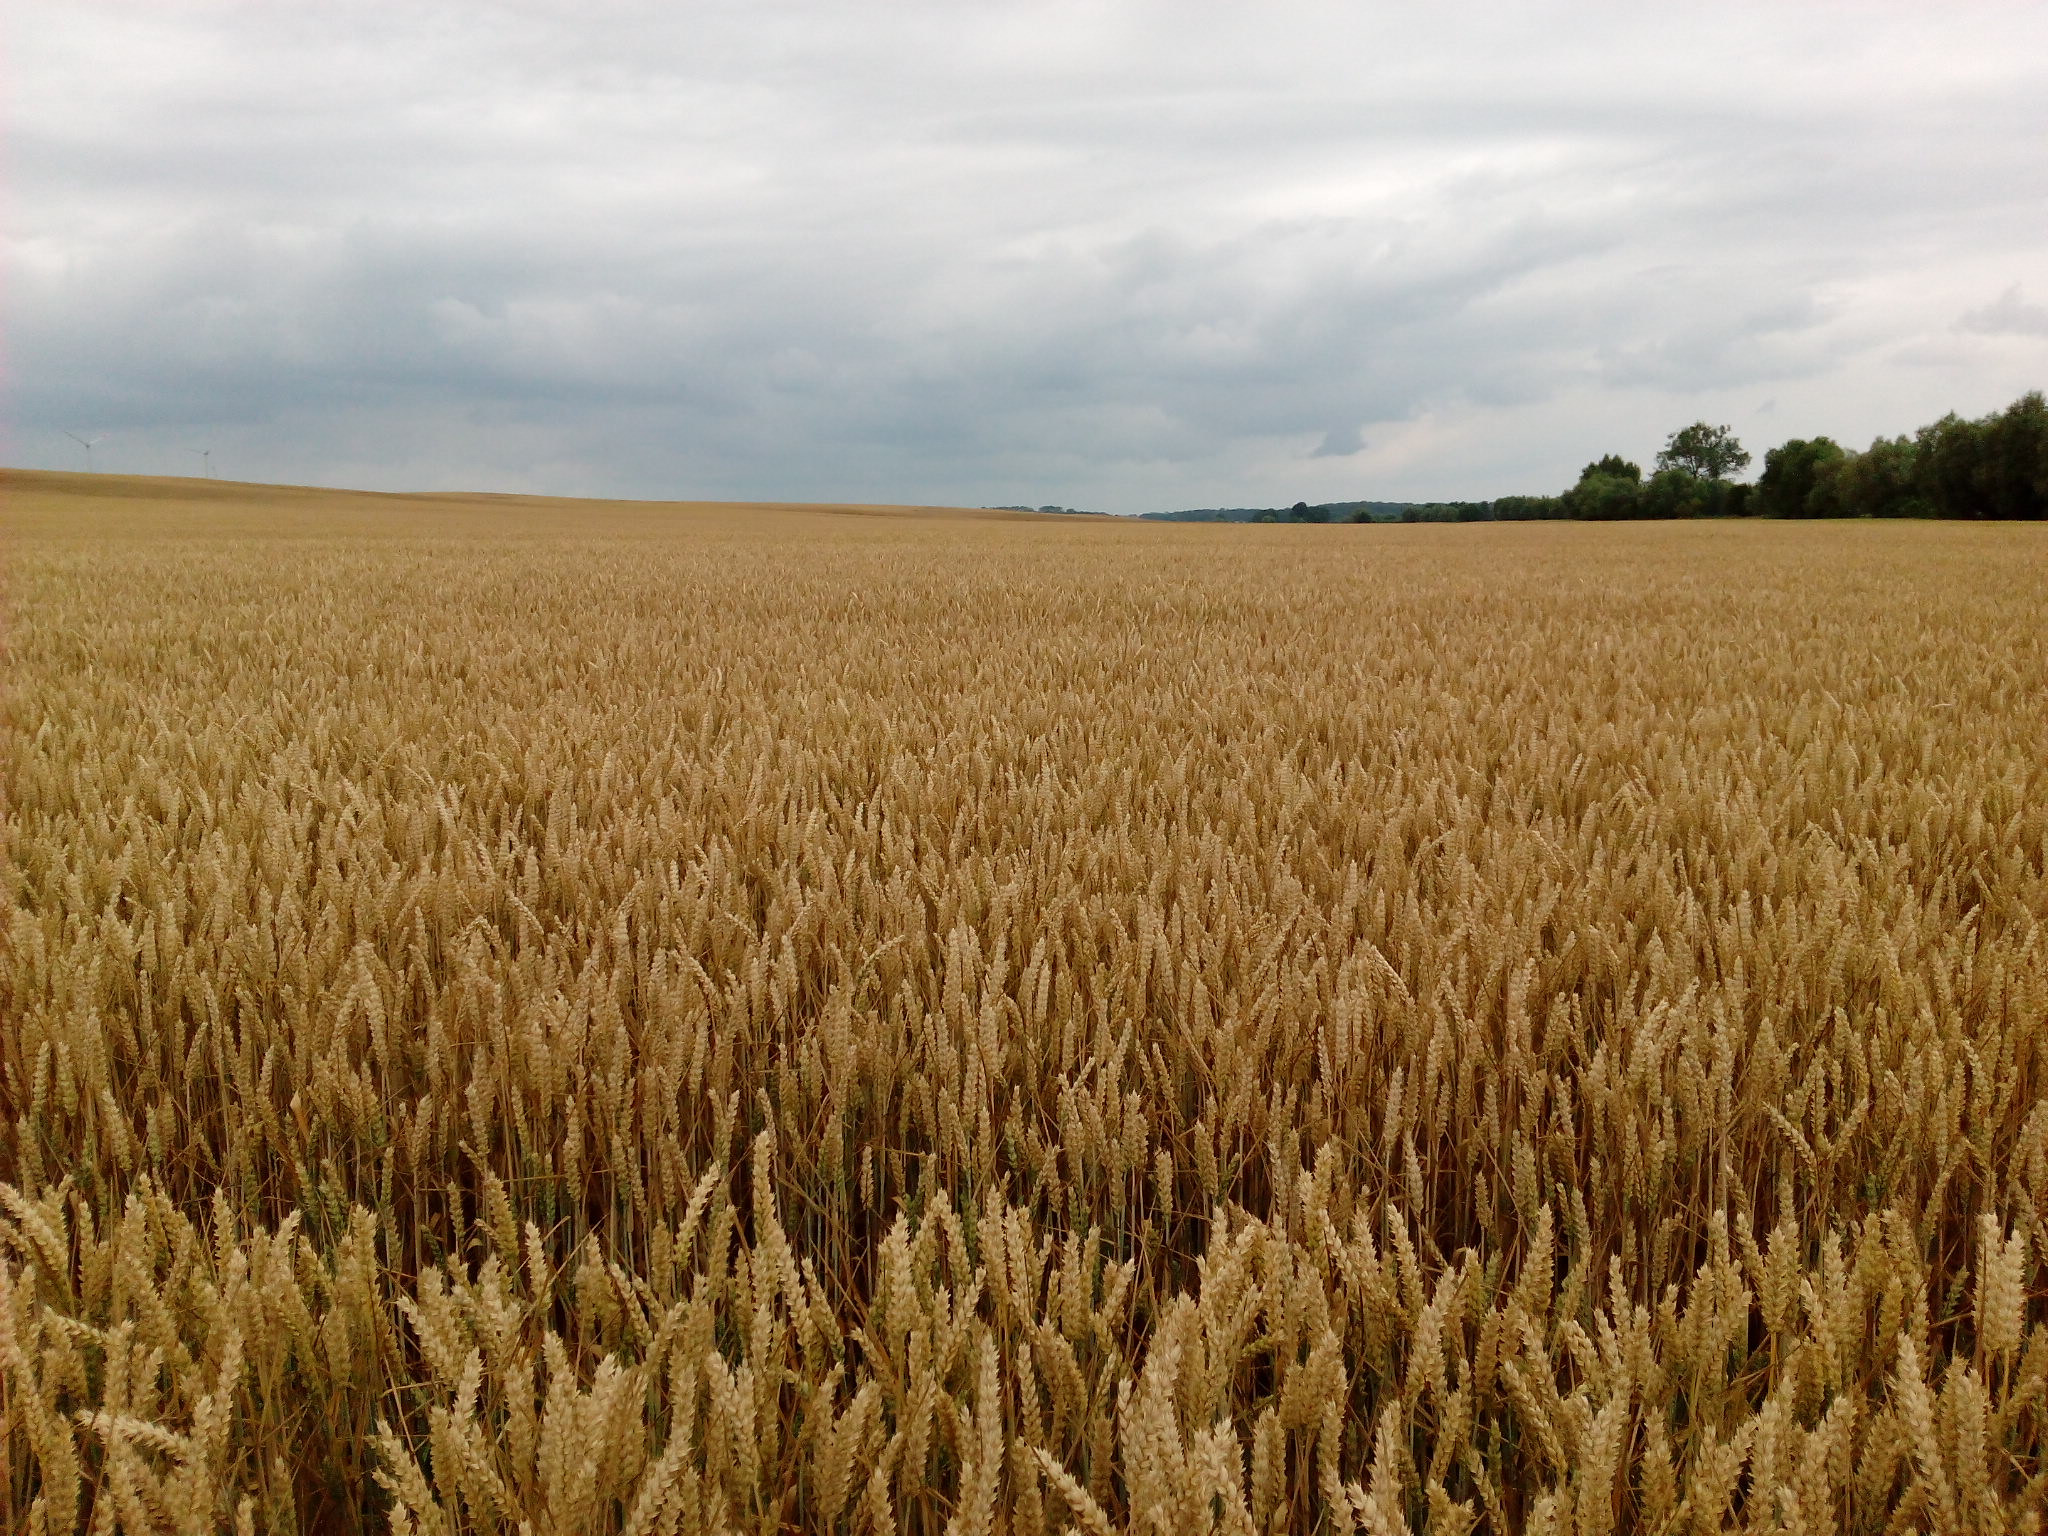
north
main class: Cropland
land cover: Common wheat
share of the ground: > 75 %
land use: Agriculture (excluding fallow land and kitchen gardens)
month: July
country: DE
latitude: 53.3833
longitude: 14.1952
